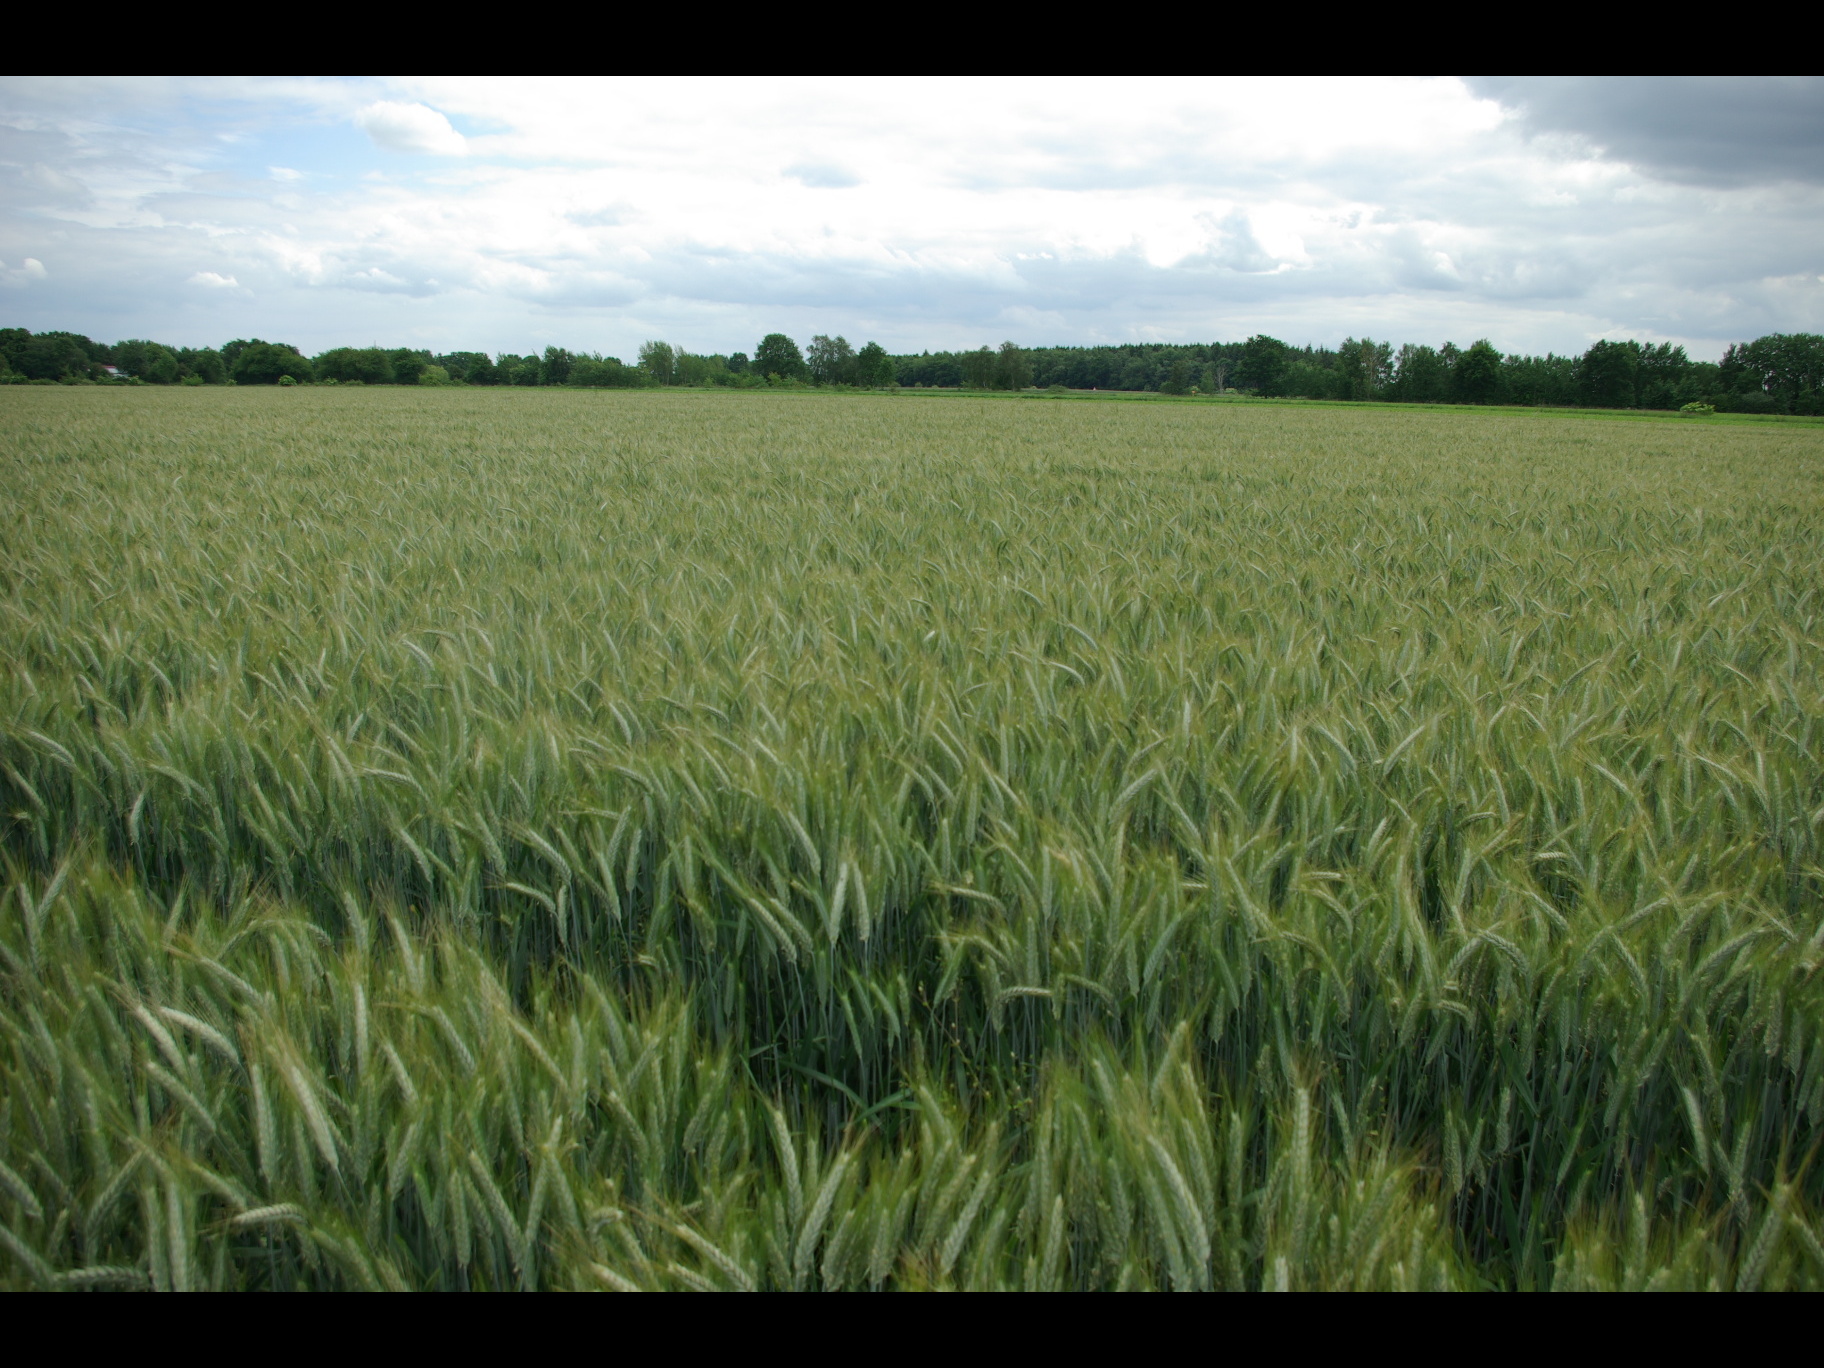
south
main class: Cropland
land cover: Triticale
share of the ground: > 75 %
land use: Agriculture (excluding fallow land and kitchen gardens)
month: June
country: DE
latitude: 54.1028
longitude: 9.9236
